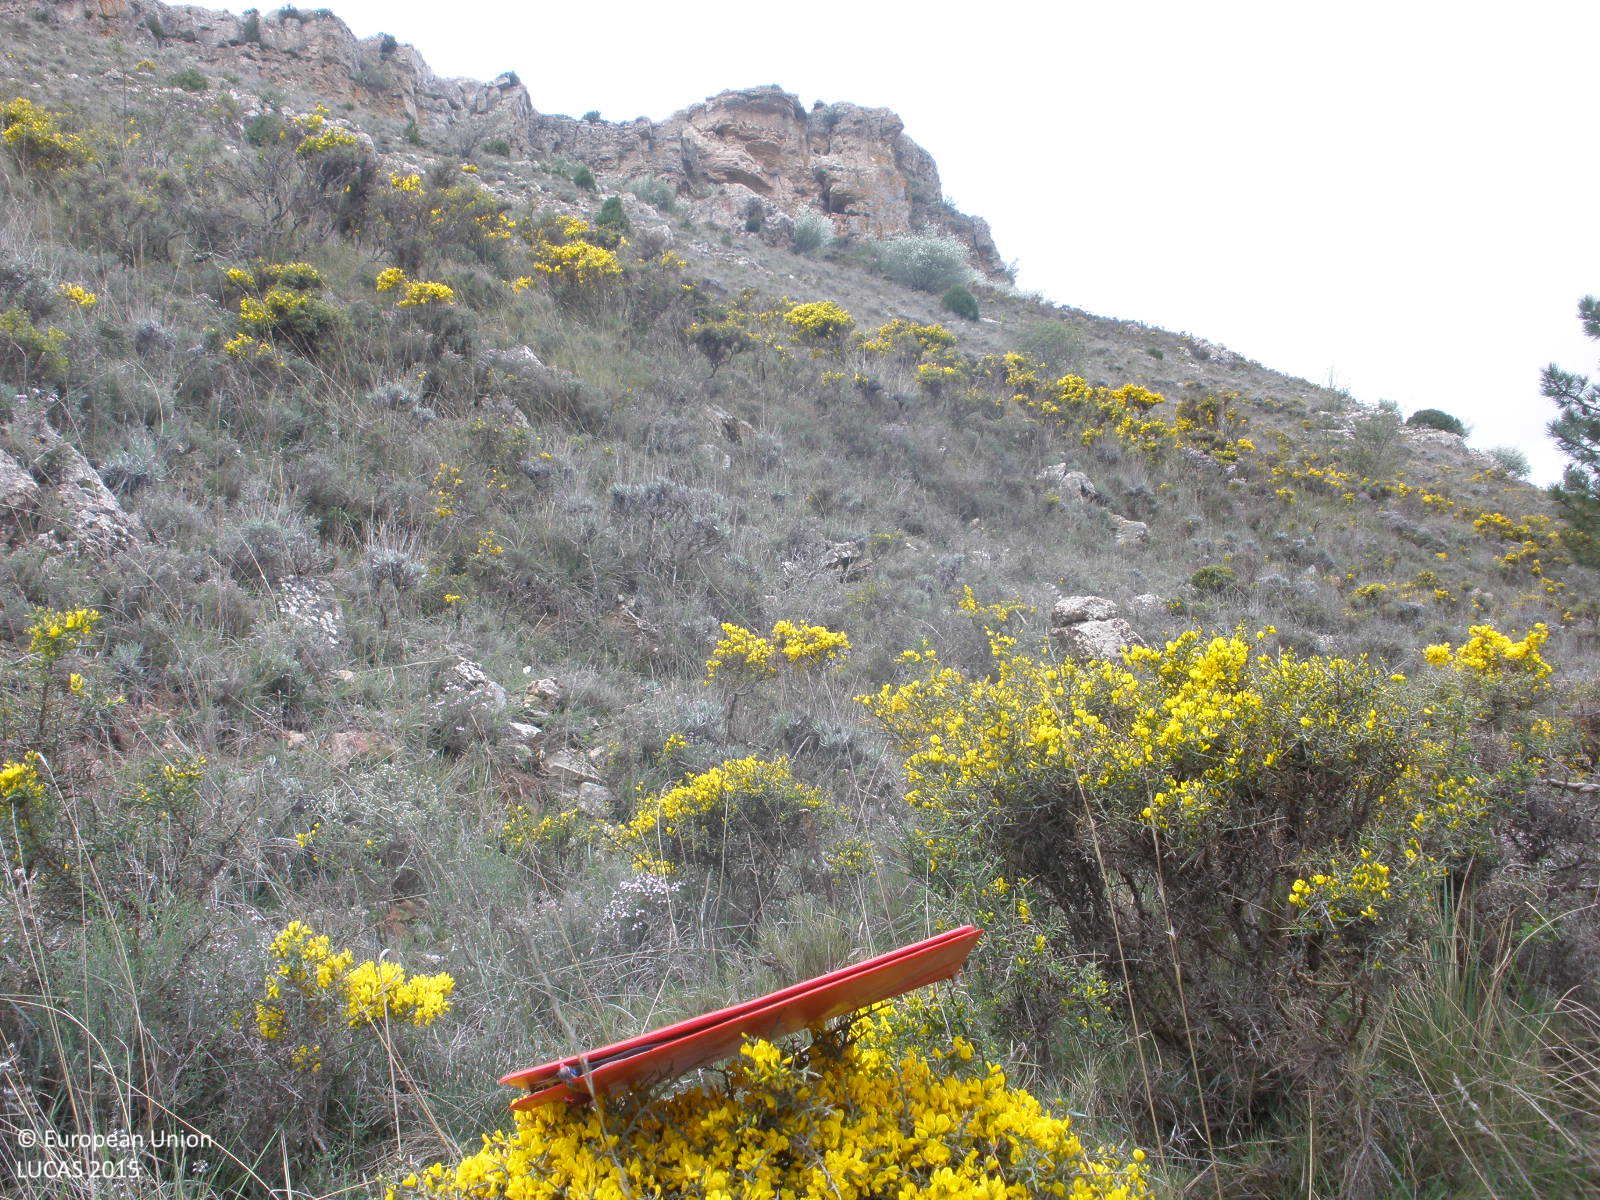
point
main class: Woodland
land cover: Pine dominated coniferous woodland
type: coniferous forest of the mediterranean region
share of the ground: 10 - 25 %
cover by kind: shrubs 50 %, herbaceous plants 30 %, coniferous forest trees 20 %
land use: Semi-natural and natural areas not in use
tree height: < 5 m
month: May
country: ES
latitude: 40.9671
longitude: -0.9358
